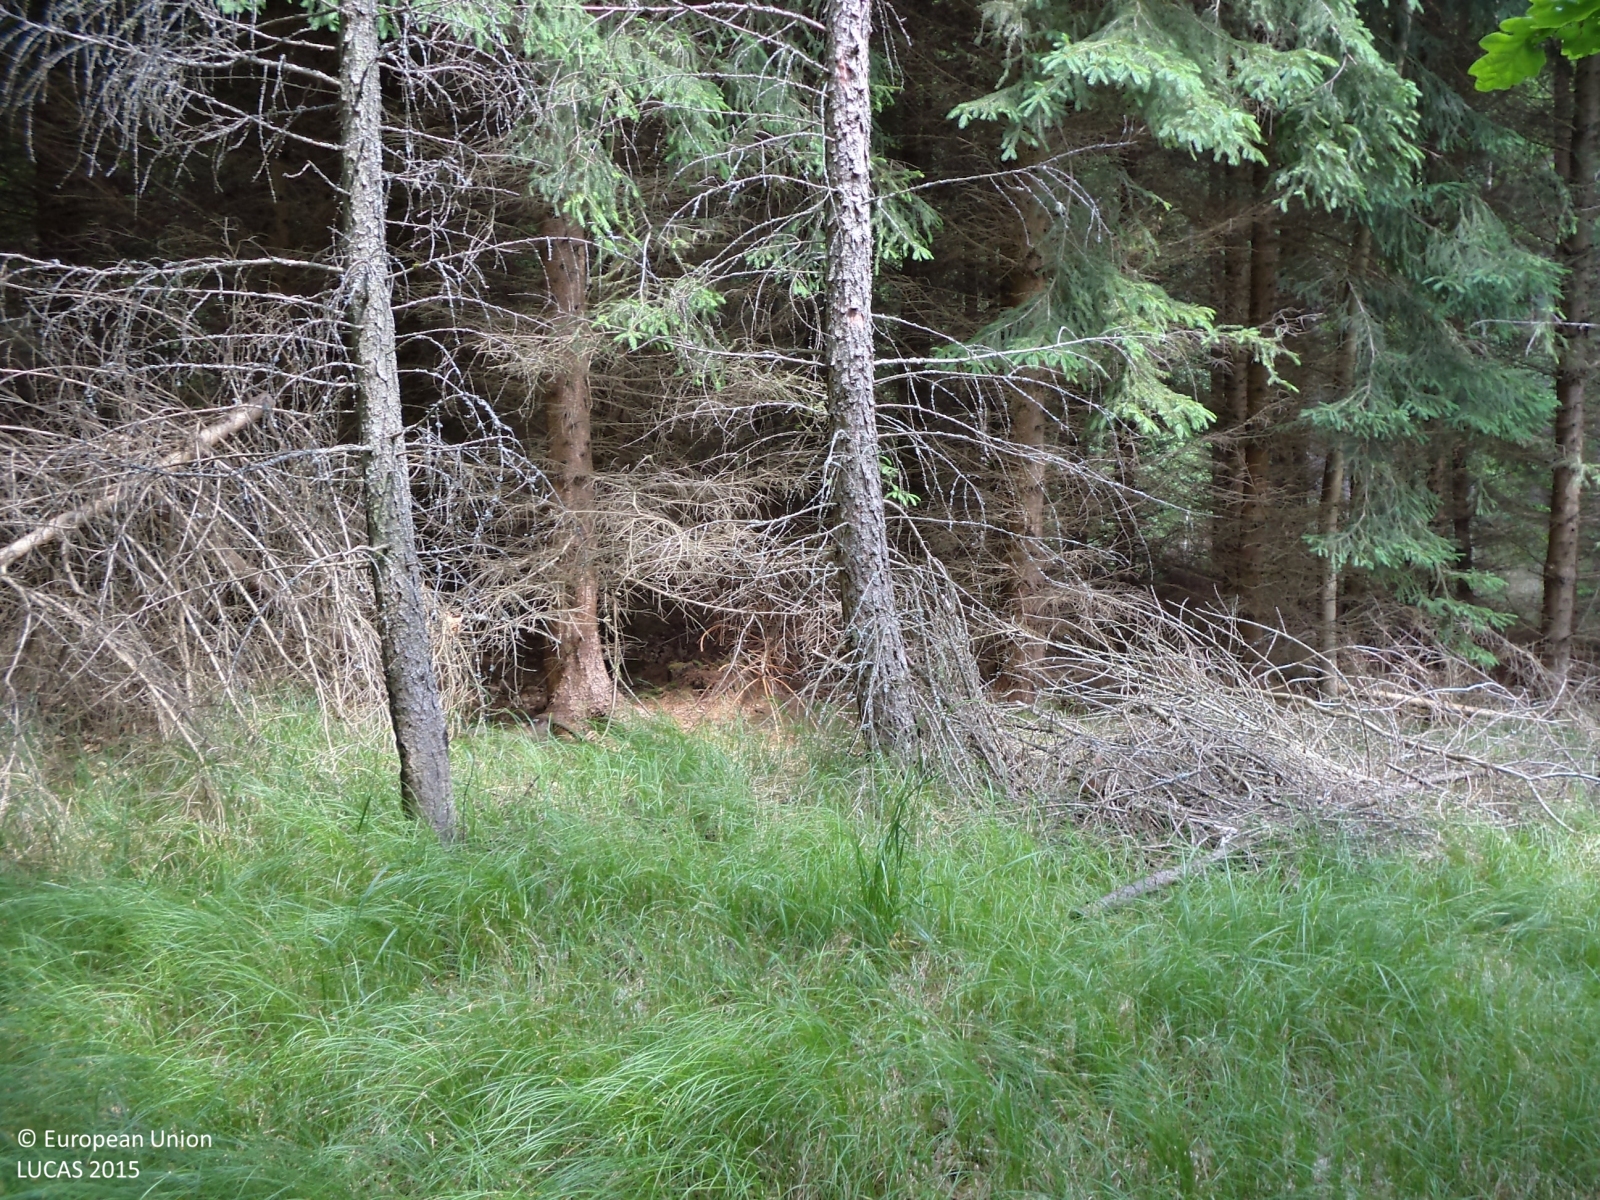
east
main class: Woodland
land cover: Pine dominated mixed woodland
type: hemiboreal forest and nemoral coniferous forest and mixed broadleaved-coniferous forest
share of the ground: > 75 %
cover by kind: coniferous forest trees 50 %, broadleaved forest trees 40 %, herbaceous plants 10 %
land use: Forestry
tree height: > 5 m
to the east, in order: Pine dominated mixed woodland; Spruce dominated coniferous woodland; Ditches and canals; Spruce dominated mixed woodland; Tracks; Ditches and canals; Spruce dominated mixed woodland; Spruce dominated coniferous woodland; Tracks; Spruce dominated coniferous woodland
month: June
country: CZ
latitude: 49.1436
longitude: 14.4290
